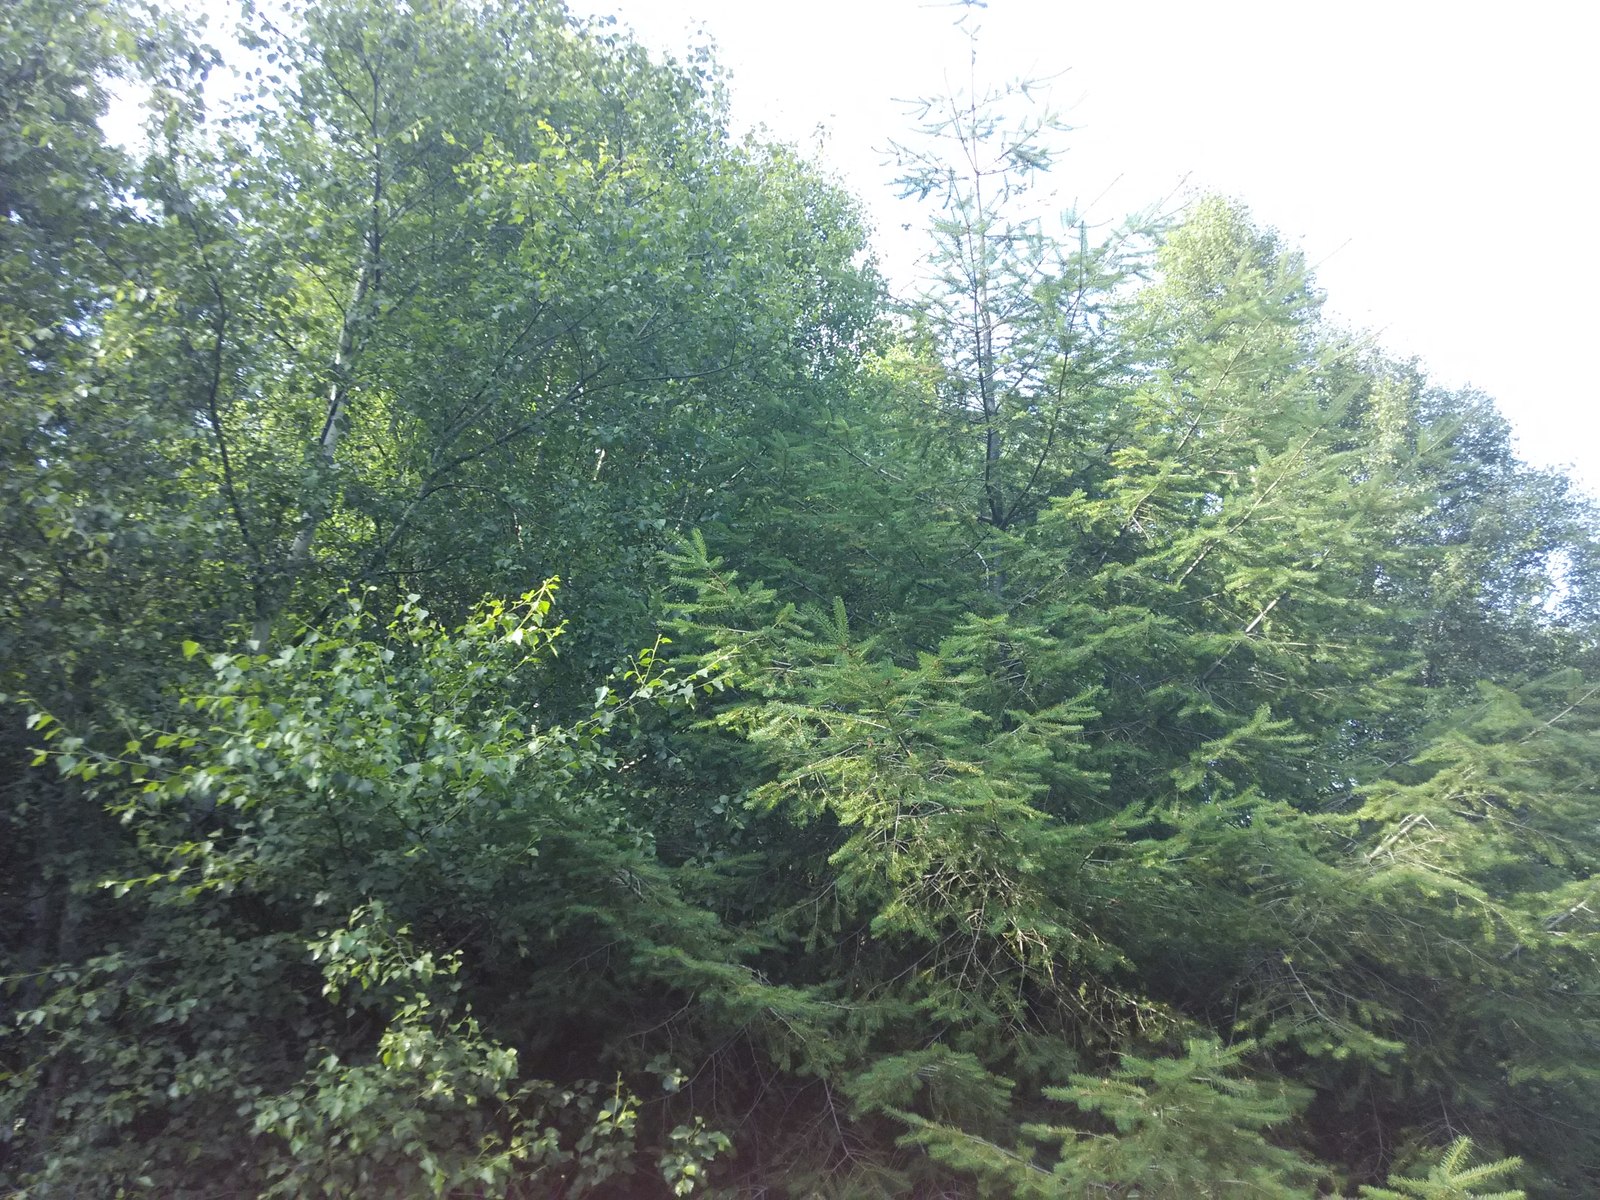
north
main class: Grassland
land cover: Grassland with sparse tree/shrub cover
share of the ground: > 75 %
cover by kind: herbaceous plants 95 %, coniferous forest trees 5 %
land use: Semi-natural and natural areas not in use
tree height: > 5 m
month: June
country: ES
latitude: 43.0312
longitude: -2.3092
